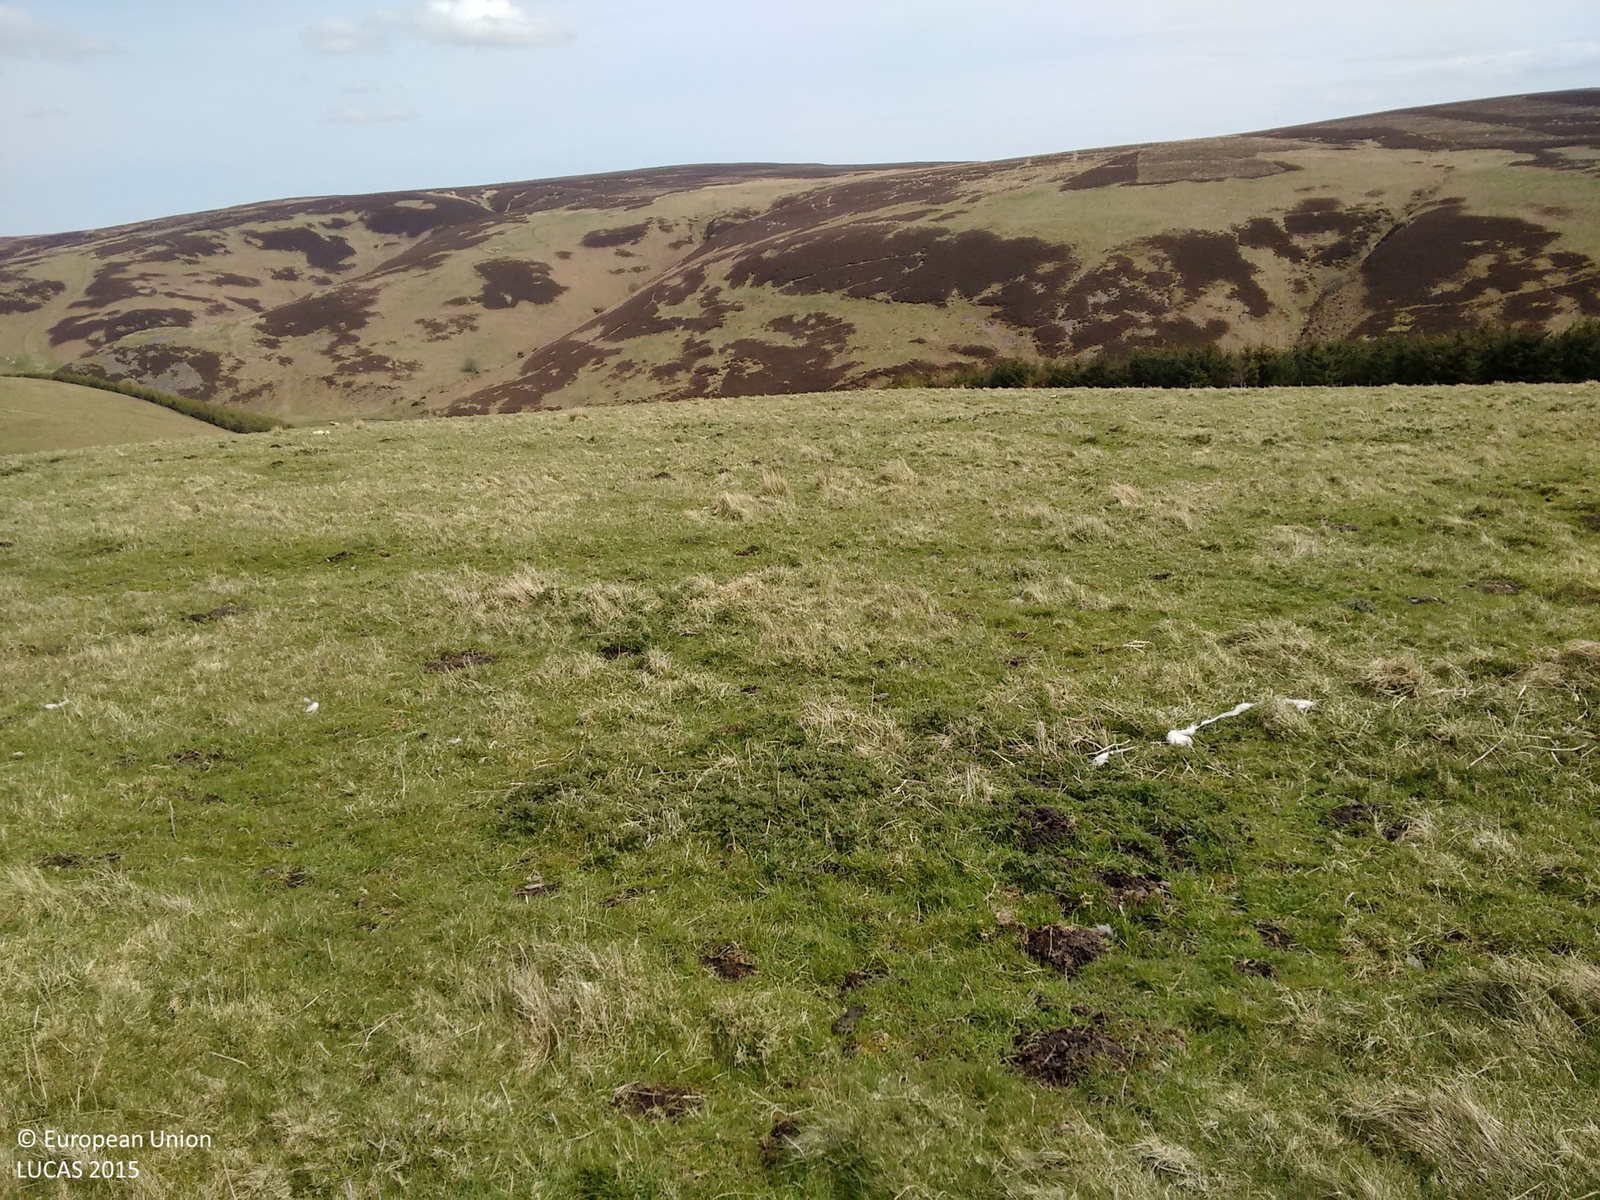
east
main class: Grassland
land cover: Grassland without tree/shrub cover
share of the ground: > 75 %
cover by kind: herbaceous plants 100 %
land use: Agriculture (excluding fallow land and kitchen gardens)
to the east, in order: Grassland without tree/shrub cover; Fences; Other coniferous woodland
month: May
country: GB
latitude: 55.7862
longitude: -2.7417
